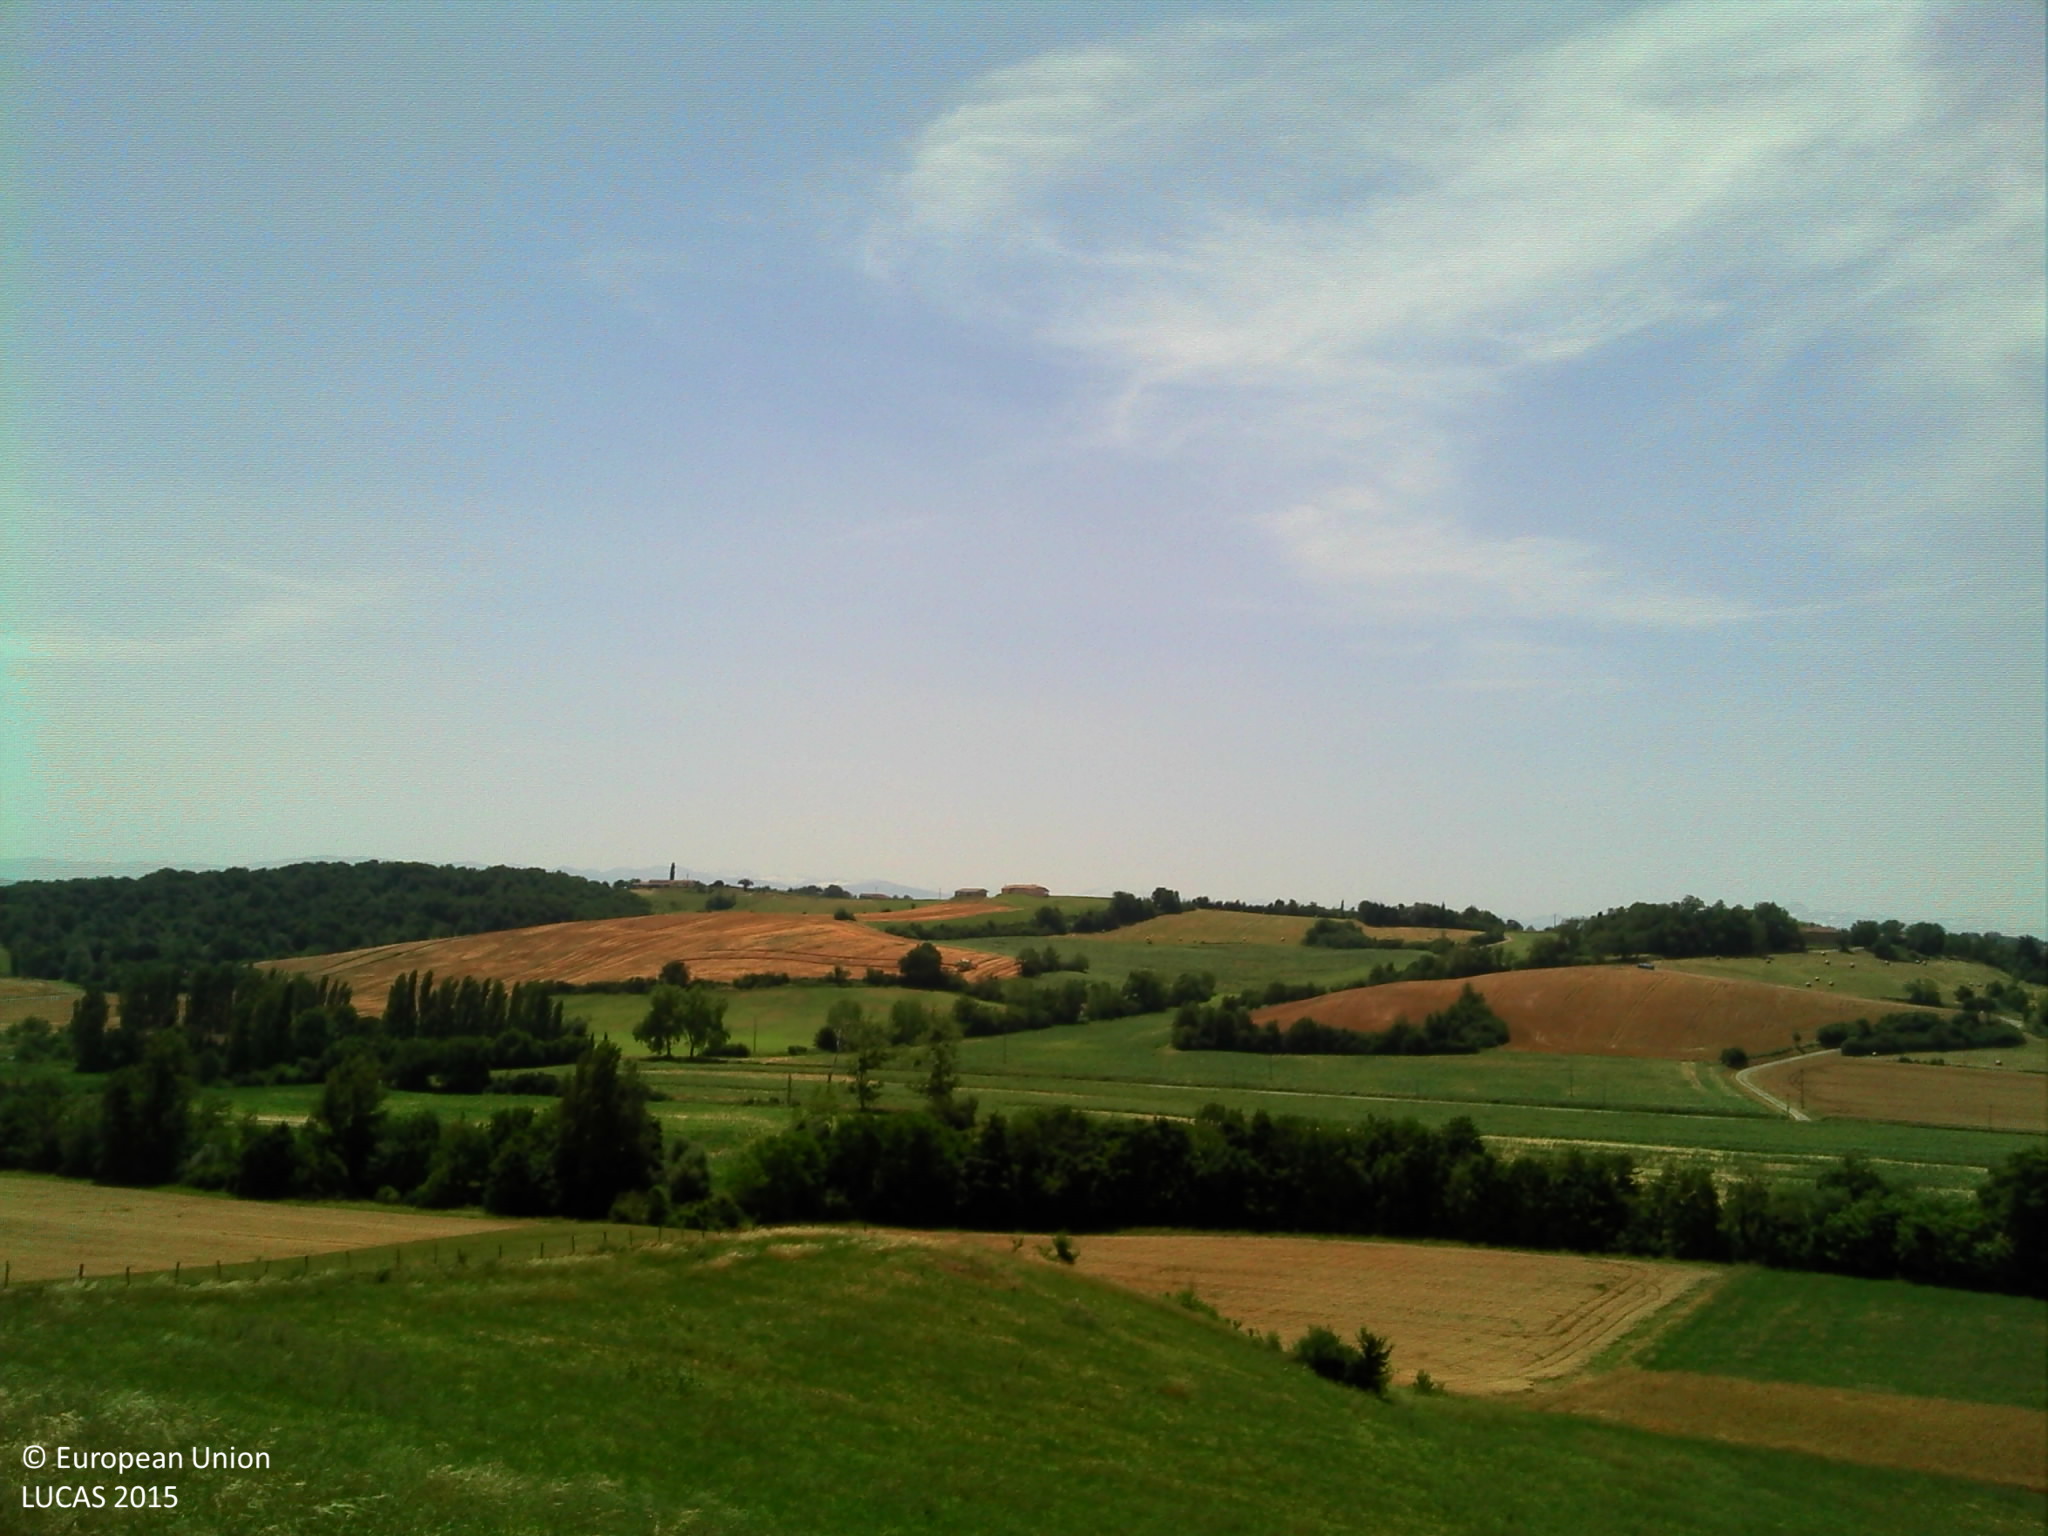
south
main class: Cropland
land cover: Other leguminous and mixtures for fodder
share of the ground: > 75 %
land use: Agriculture (excluding fallow land and kitchen gardens)
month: July
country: FR
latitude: 43.1835
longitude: 1.4788
